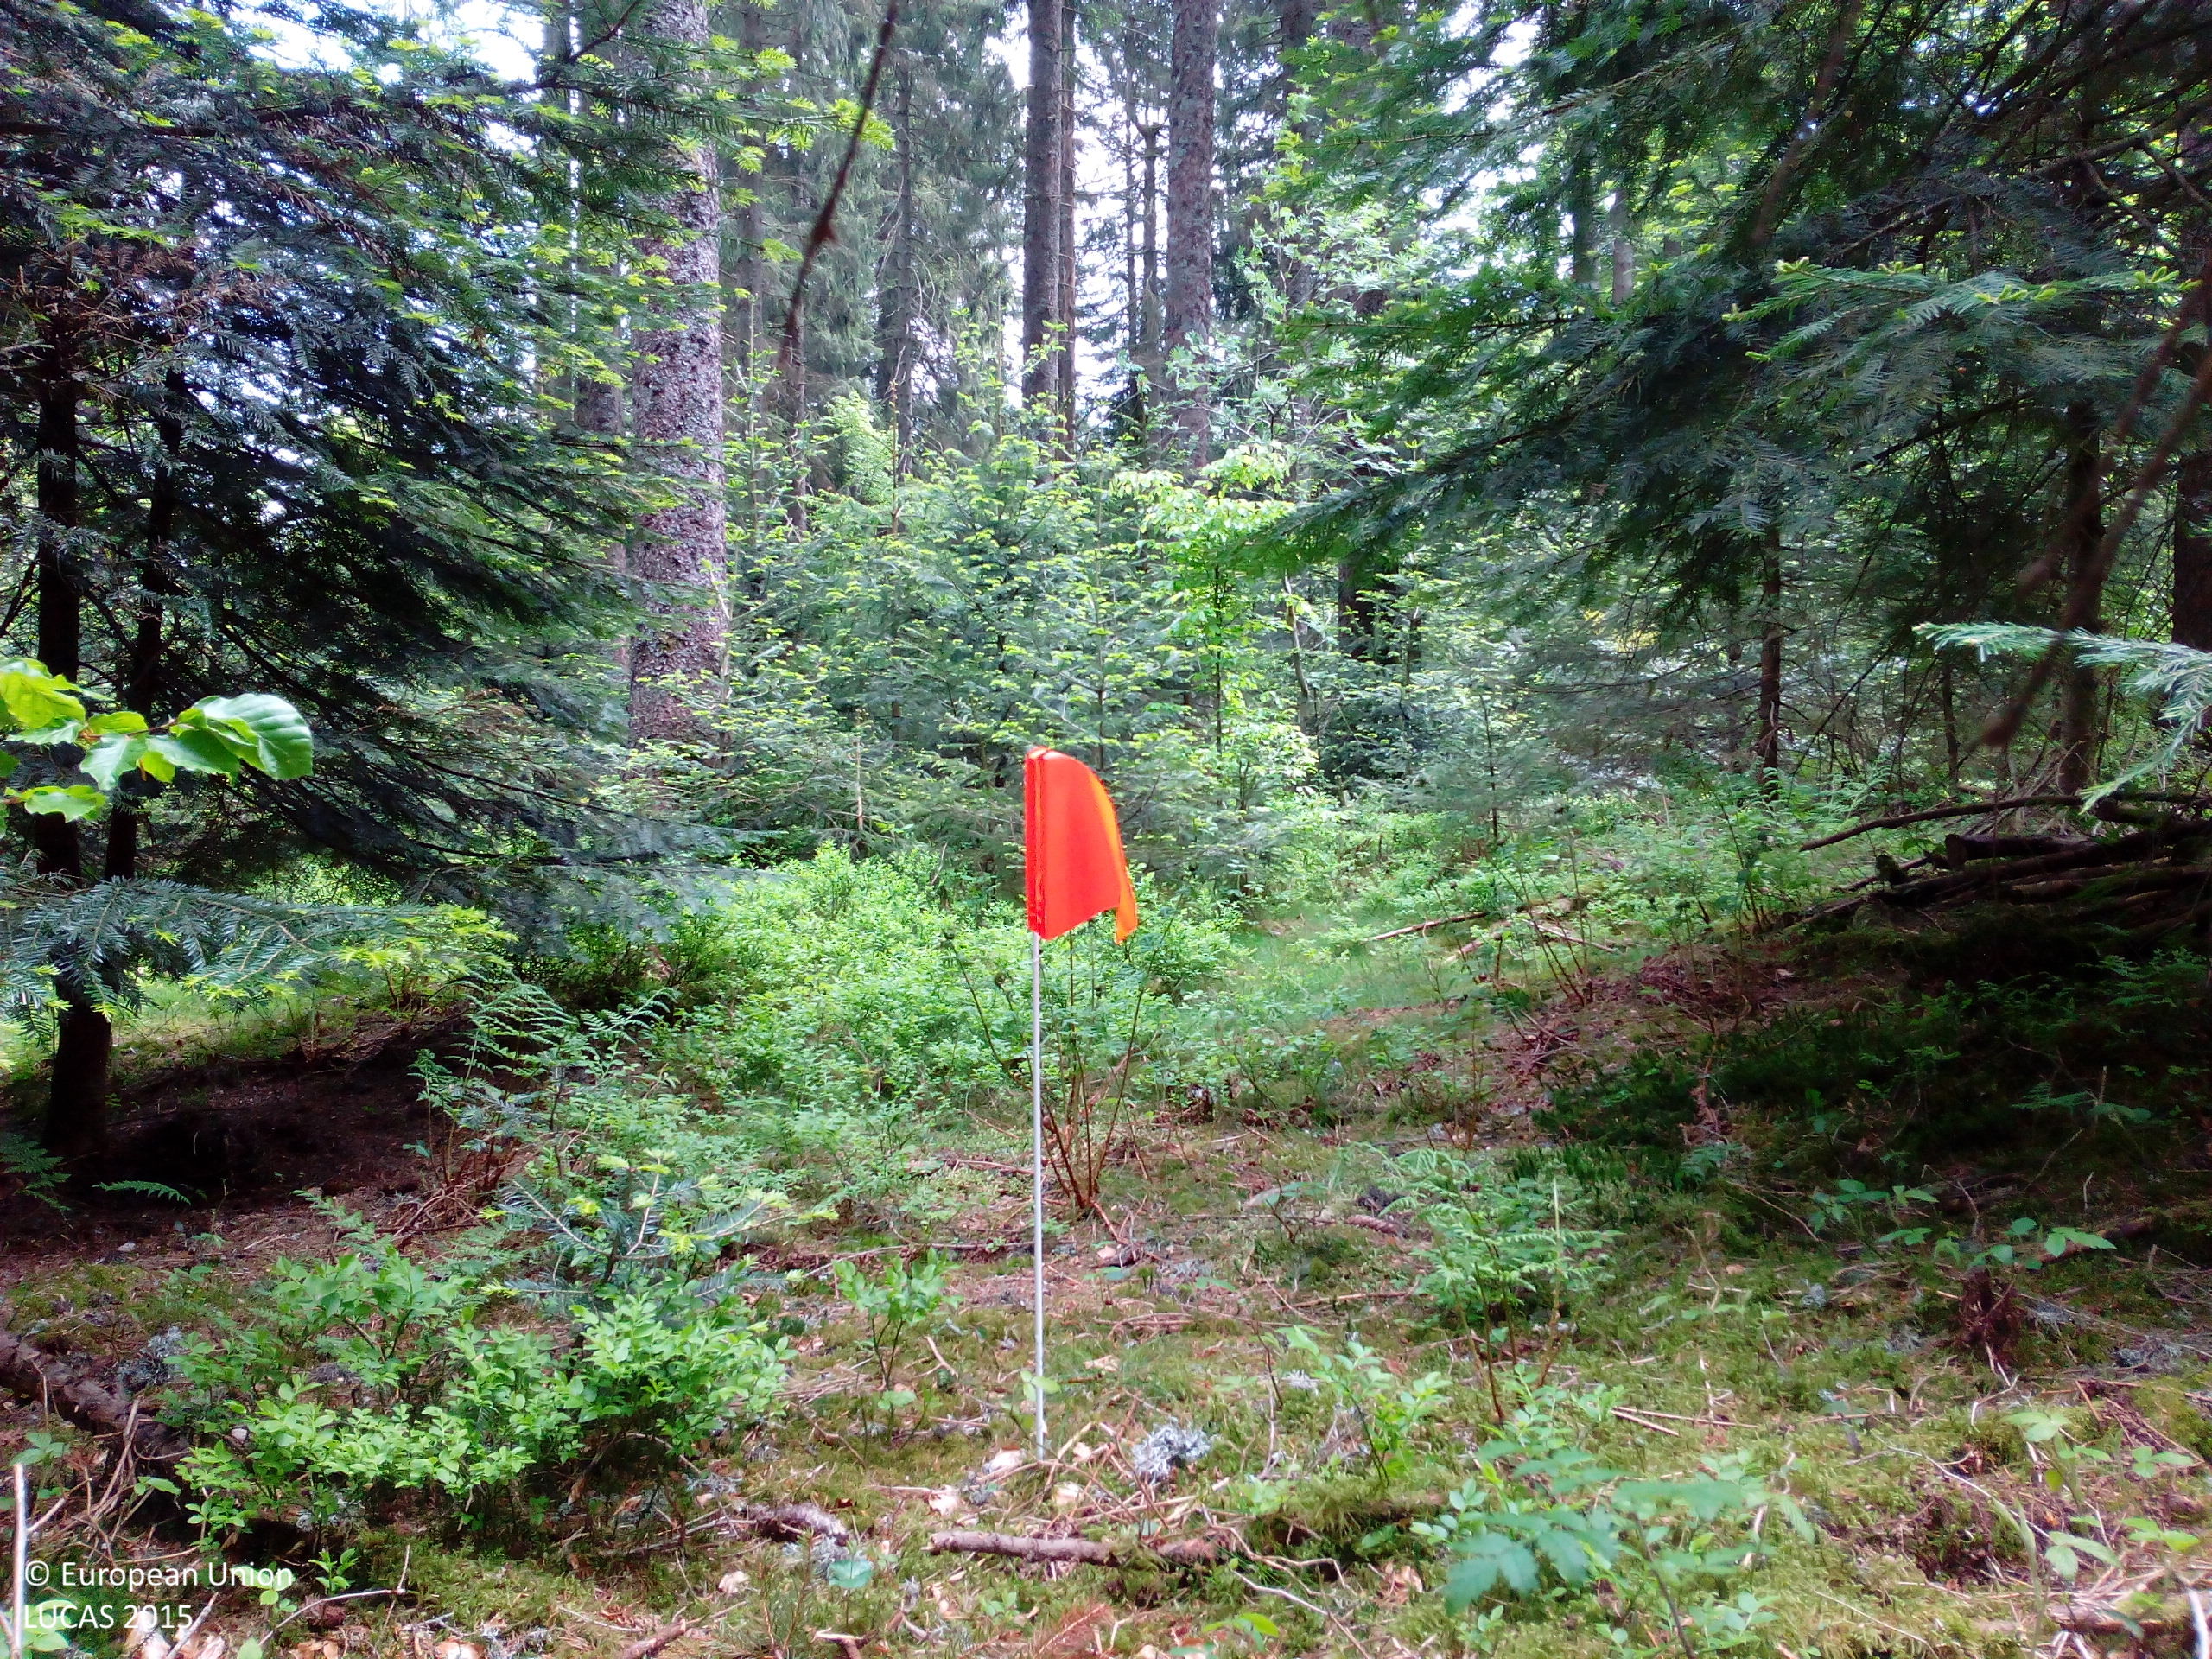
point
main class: Woodland
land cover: Other mixed woodland
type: hemiboreal forest and nemoral coniferous forest and mixed broadleaved-coniferous forest
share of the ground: > 75 %
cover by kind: coniferous forest trees 70 %, broadleaved forest trees 30 %
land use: Forestry
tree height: > 5 m
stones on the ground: < 10 %
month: May
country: DE
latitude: 47.9918
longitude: 8.1384
